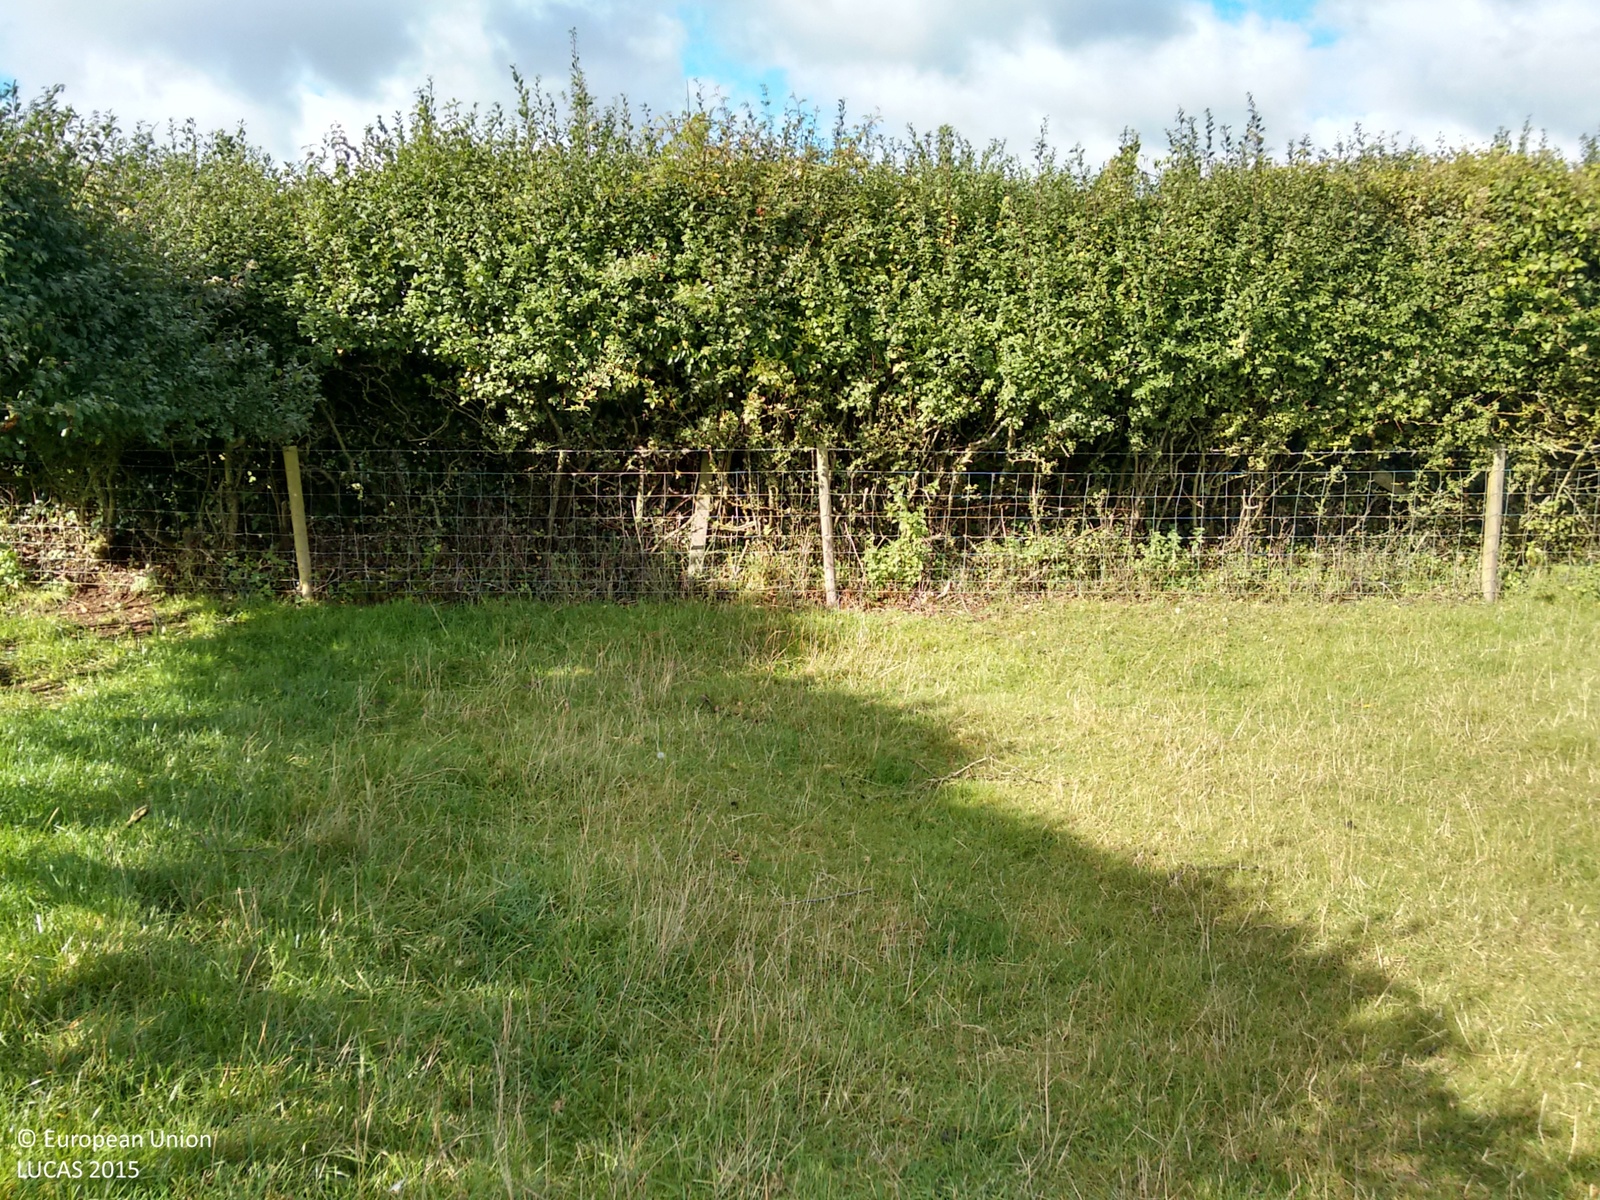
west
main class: Grassland
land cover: Grassland without tree/shrub cover
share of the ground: > 75 %
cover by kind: herbaceous plants 100 %
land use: Agriculture (excluding fallow land and kitchen gardens)
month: September
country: GB
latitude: 50.9883
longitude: -2.4742
